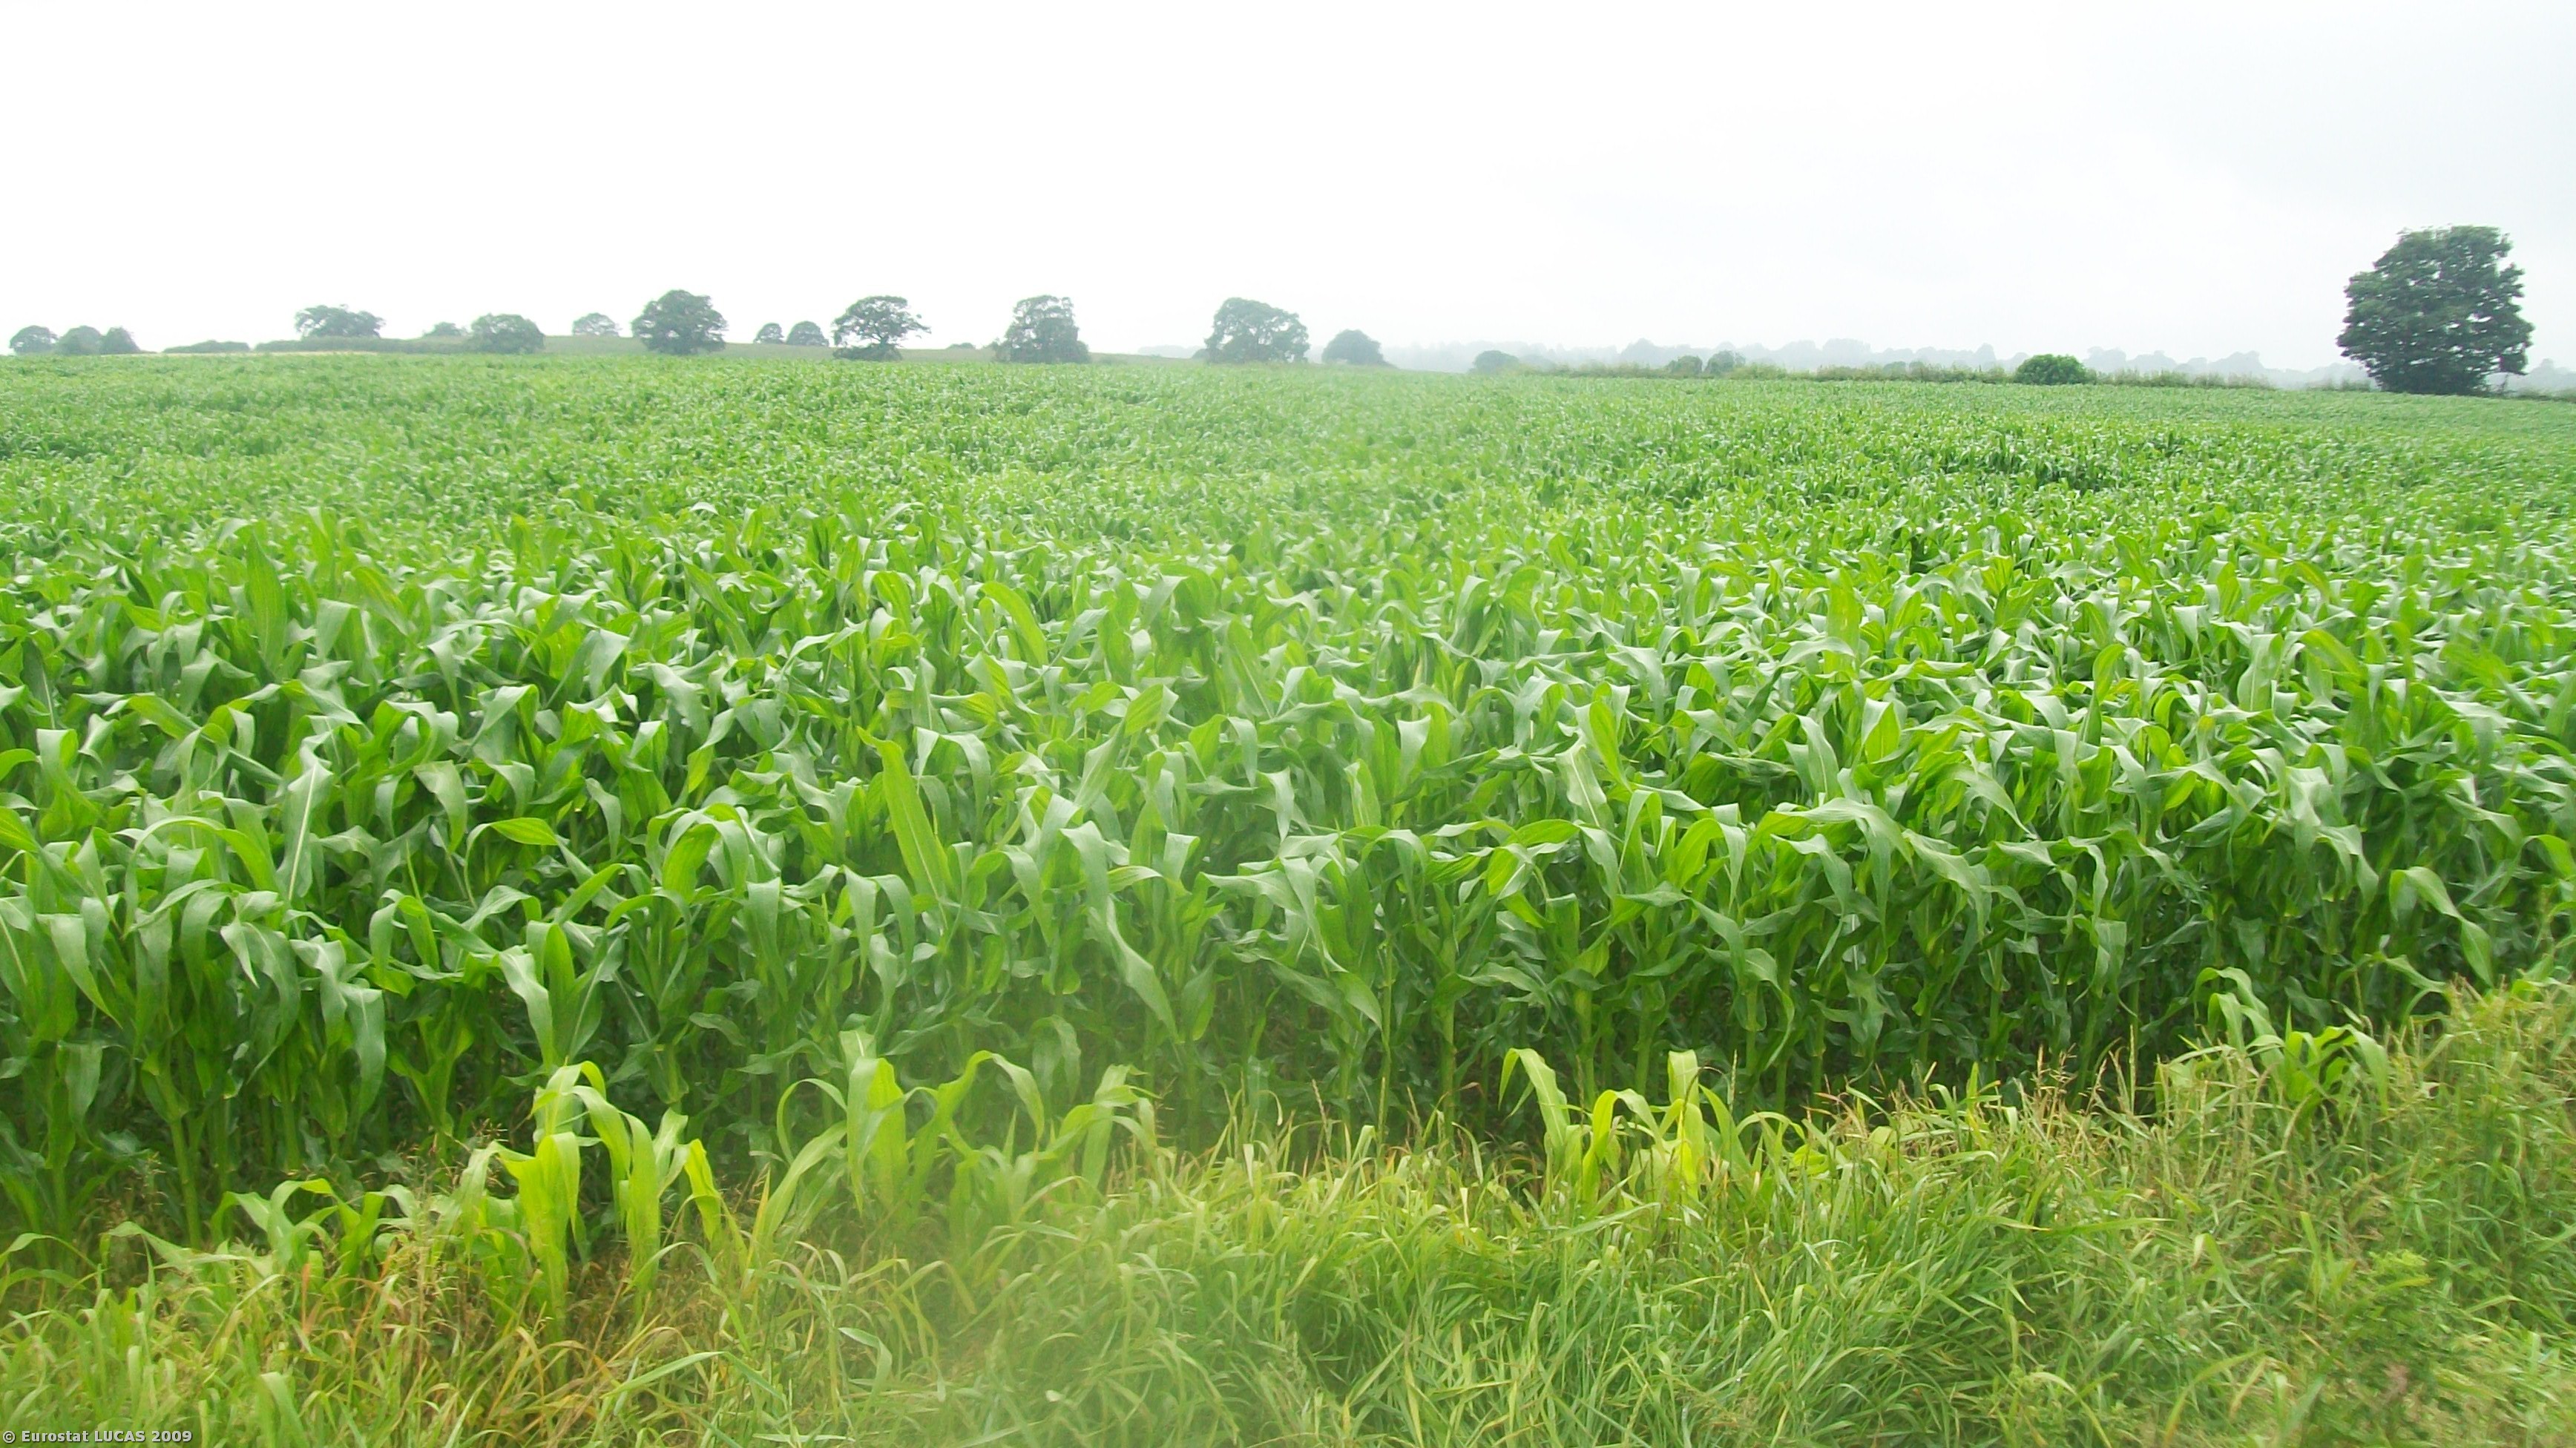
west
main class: Cropland
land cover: Maize
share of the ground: > 75 %
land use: Agriculture (excluding fallow land and kitchen gardens)
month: July
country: GB
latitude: 52.9717
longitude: -2.6513
